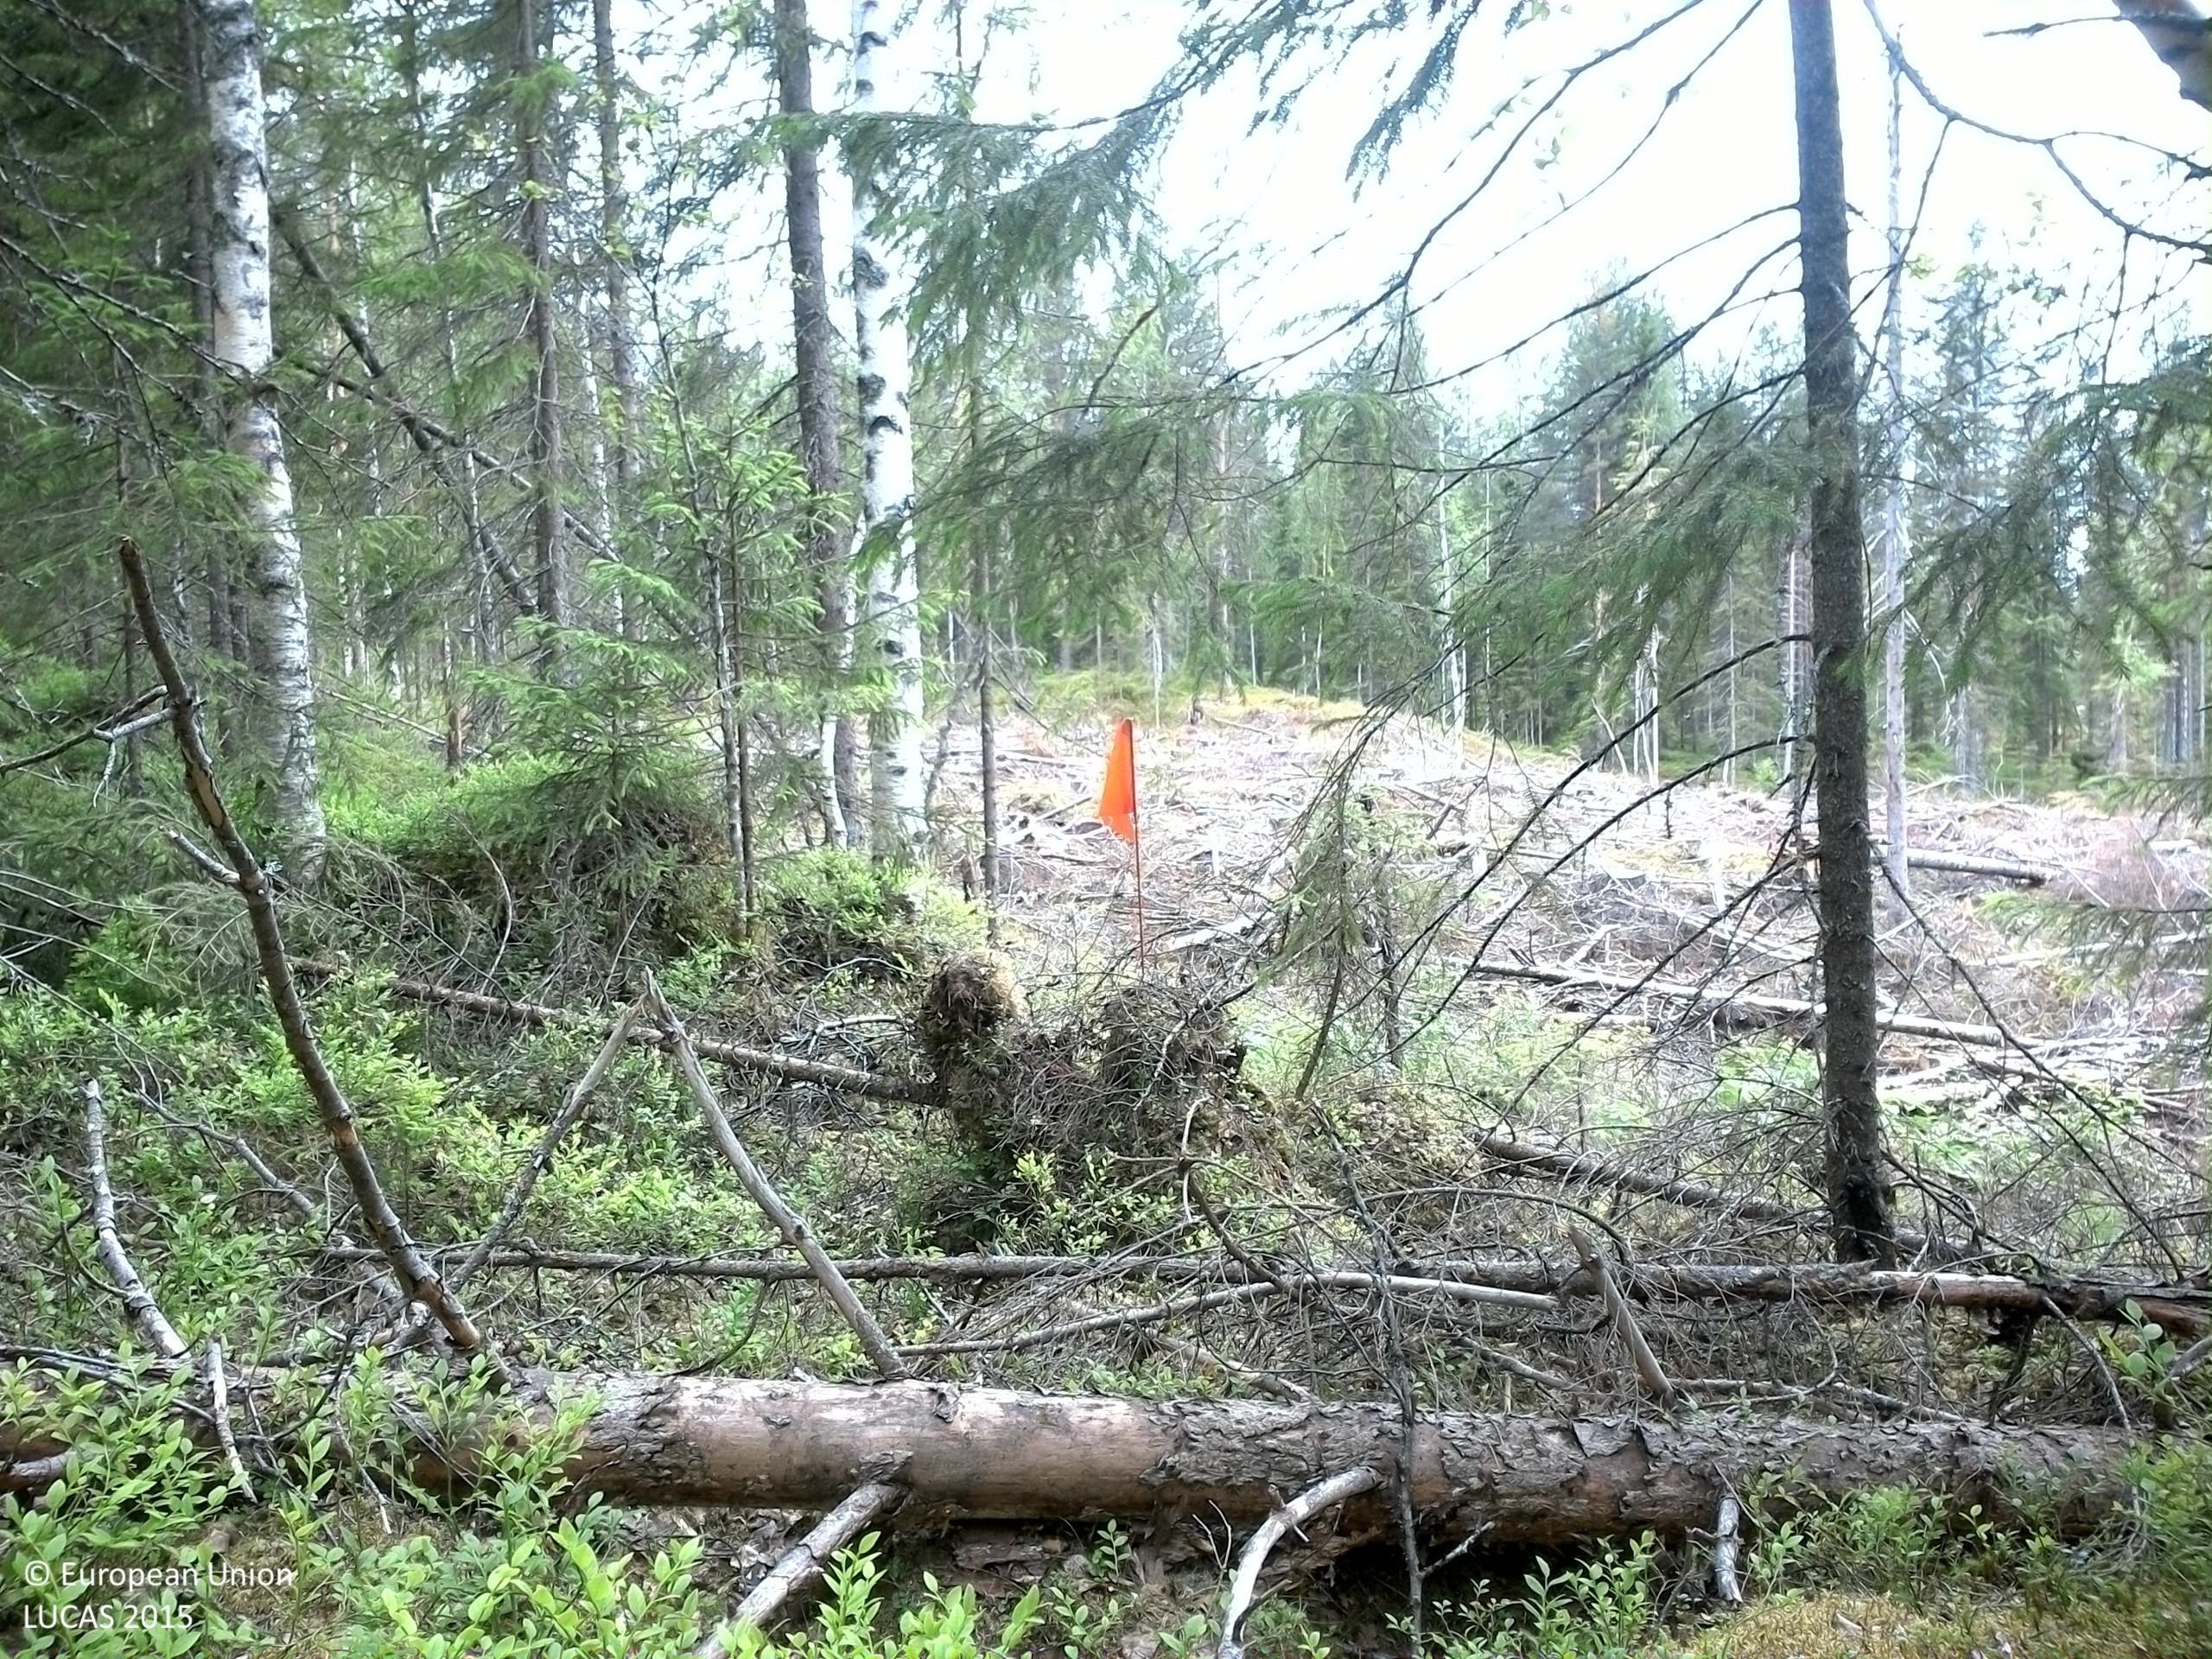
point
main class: Woodland
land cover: Spruce dominated mixed woodland
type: boreal forest
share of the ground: 50 - 75 %
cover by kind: coniferous forest trees 50 %, broadleaved forest trees 20 %, shrubs 20 %, lichens and mosses 10 %
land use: Forestry
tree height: > 5 m
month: July
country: SE
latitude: 63.6042
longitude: 17.4934
